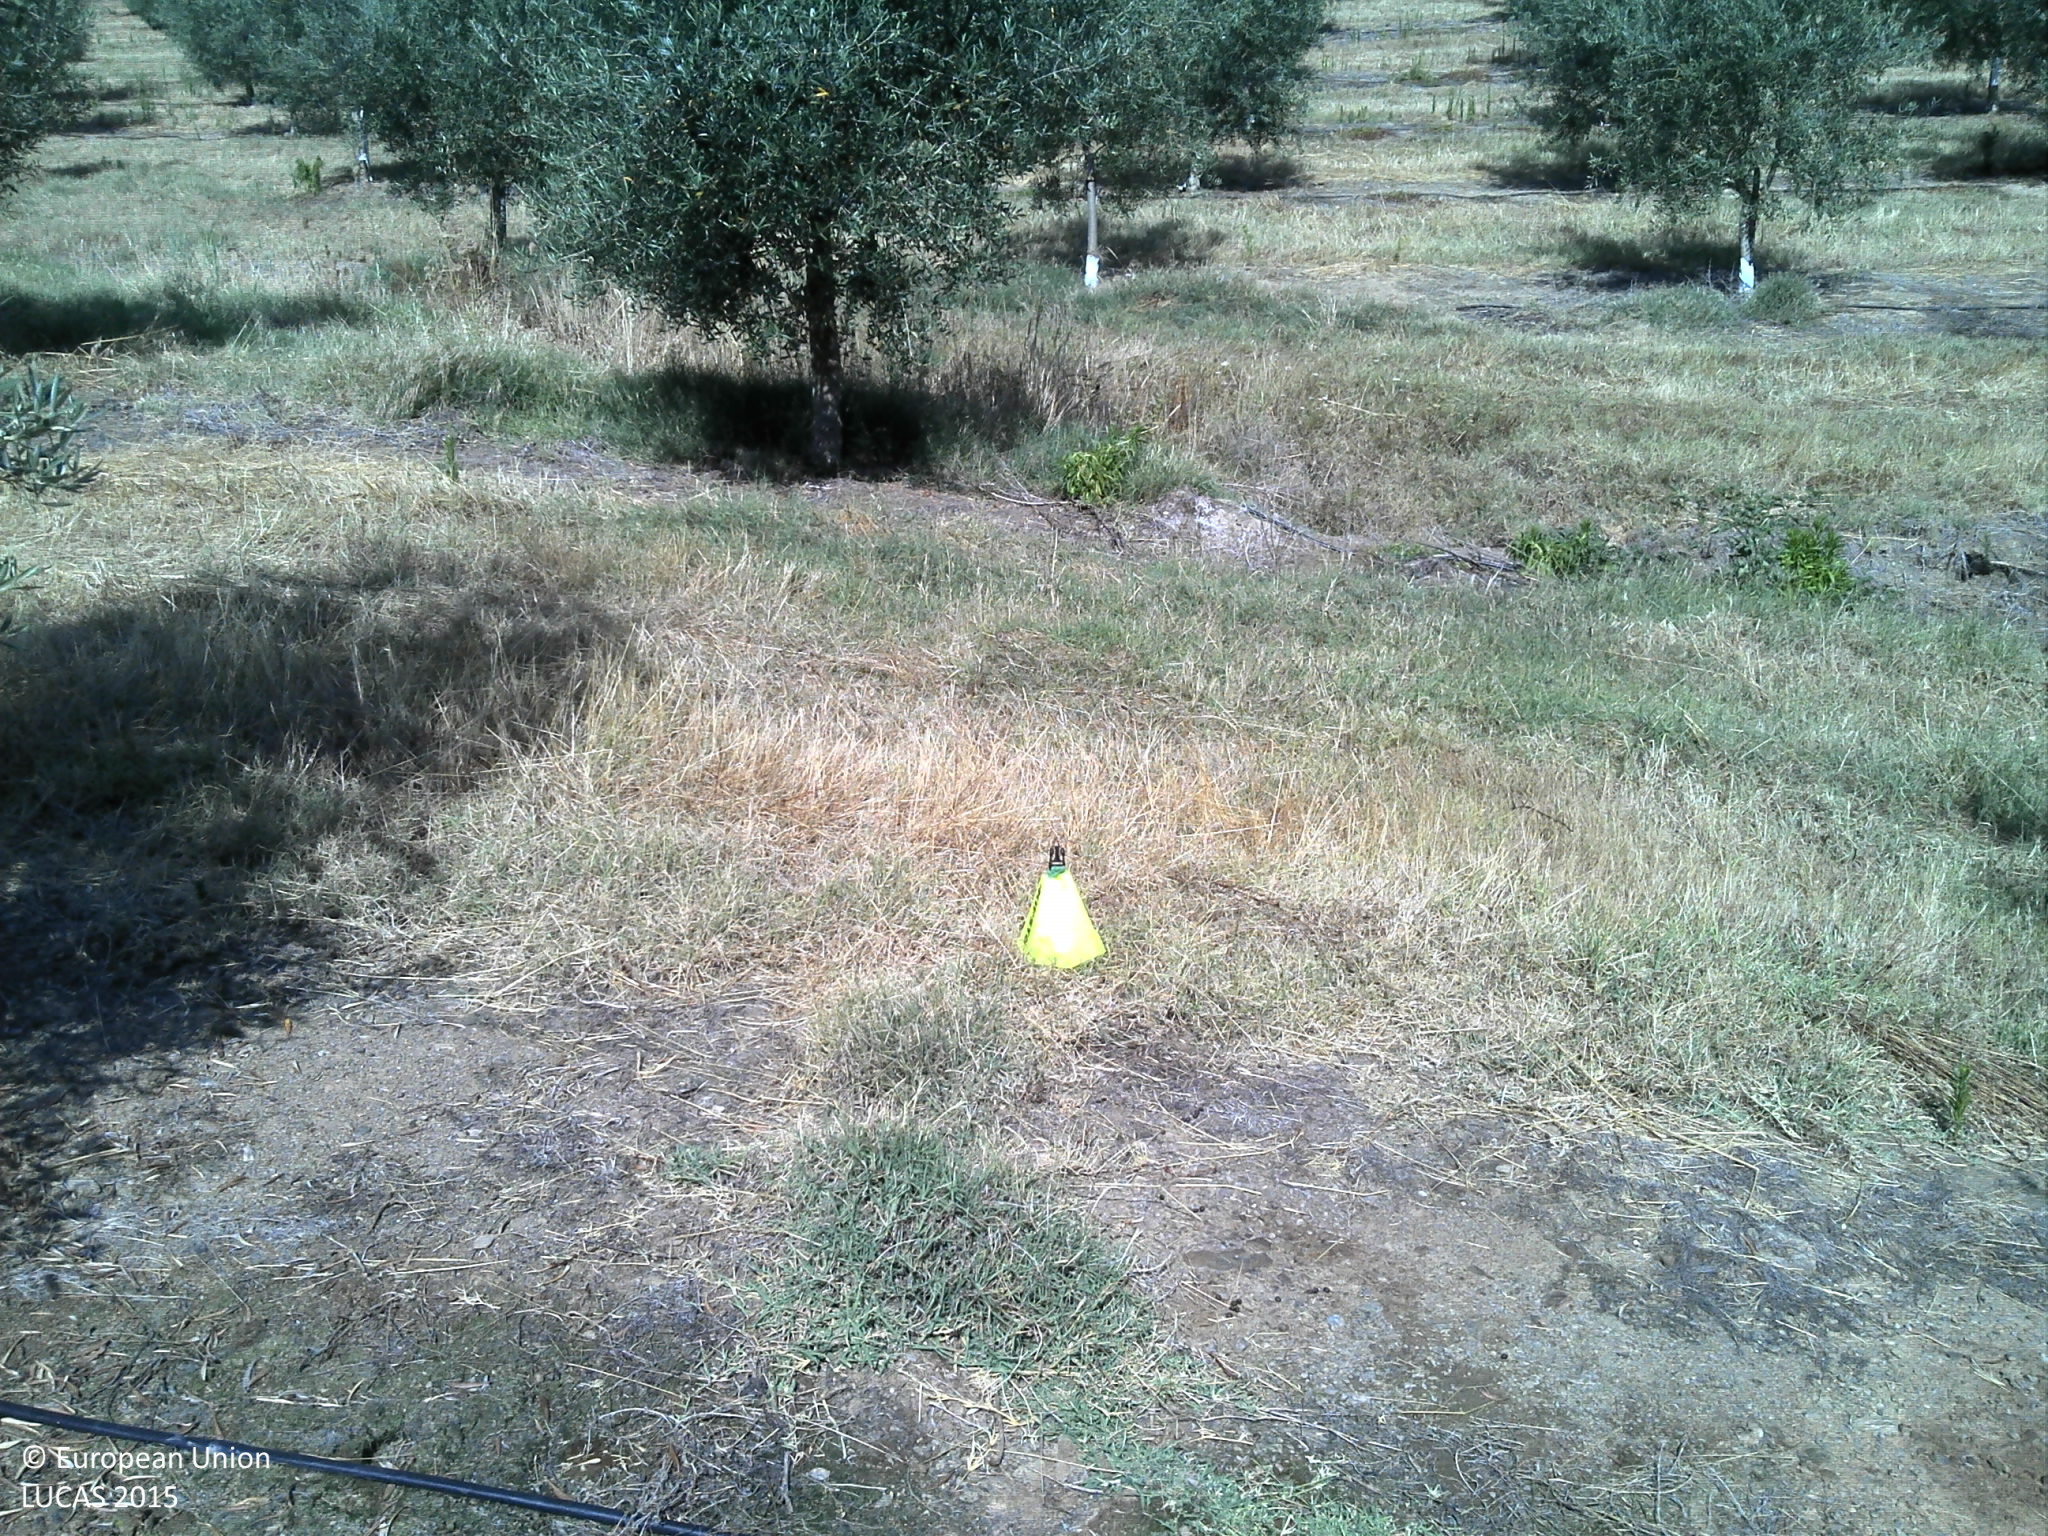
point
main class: Cropland
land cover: Olive groves
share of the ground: 10 - 25 %
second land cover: Grassland without tree/shrub cover
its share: 25 - 50 %
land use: Agriculture (excluding fallow land and kitchen gardens)
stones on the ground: < 10 %
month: July
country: PT
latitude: 38.4426
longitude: -7.6875
